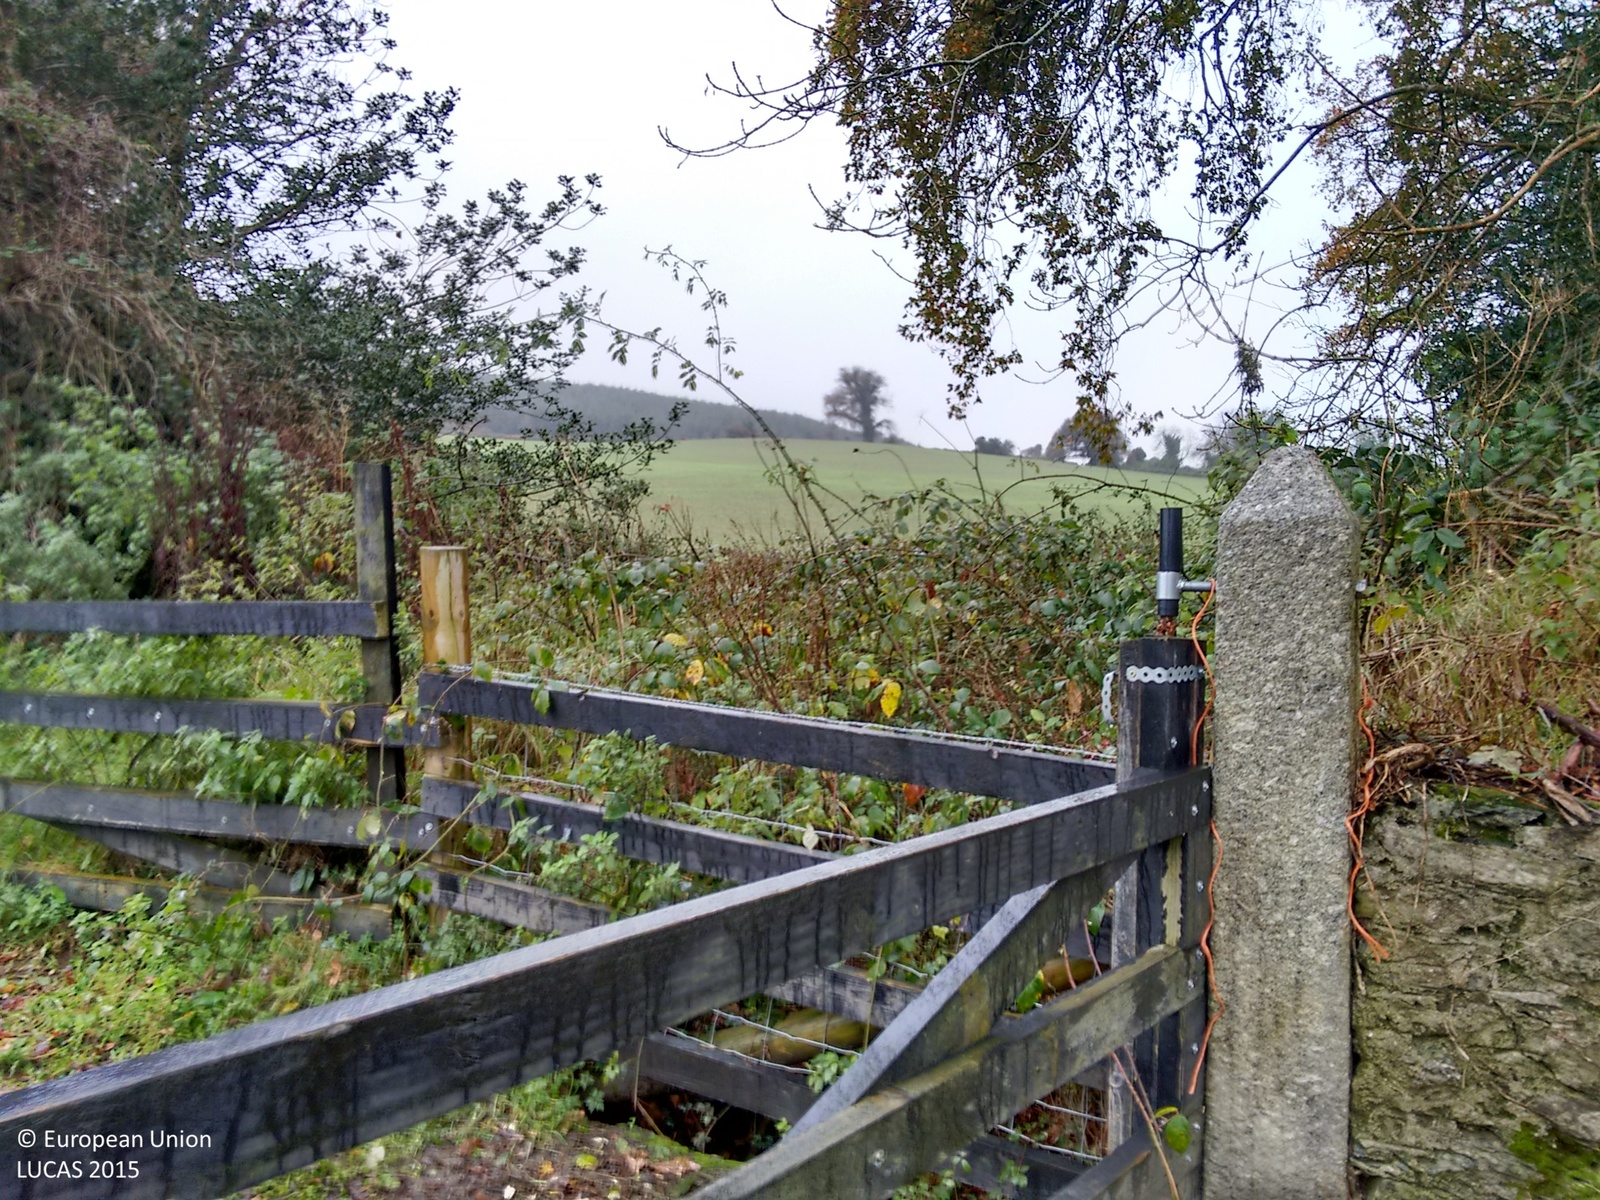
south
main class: Grassland
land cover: Grassland without tree/shrub cover
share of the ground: > 75 %
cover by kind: herbaceous plants 60 %
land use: Agriculture (excluding fallow land and kitchen gardens)
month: November
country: IE
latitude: 53.0671
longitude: -6.0990
